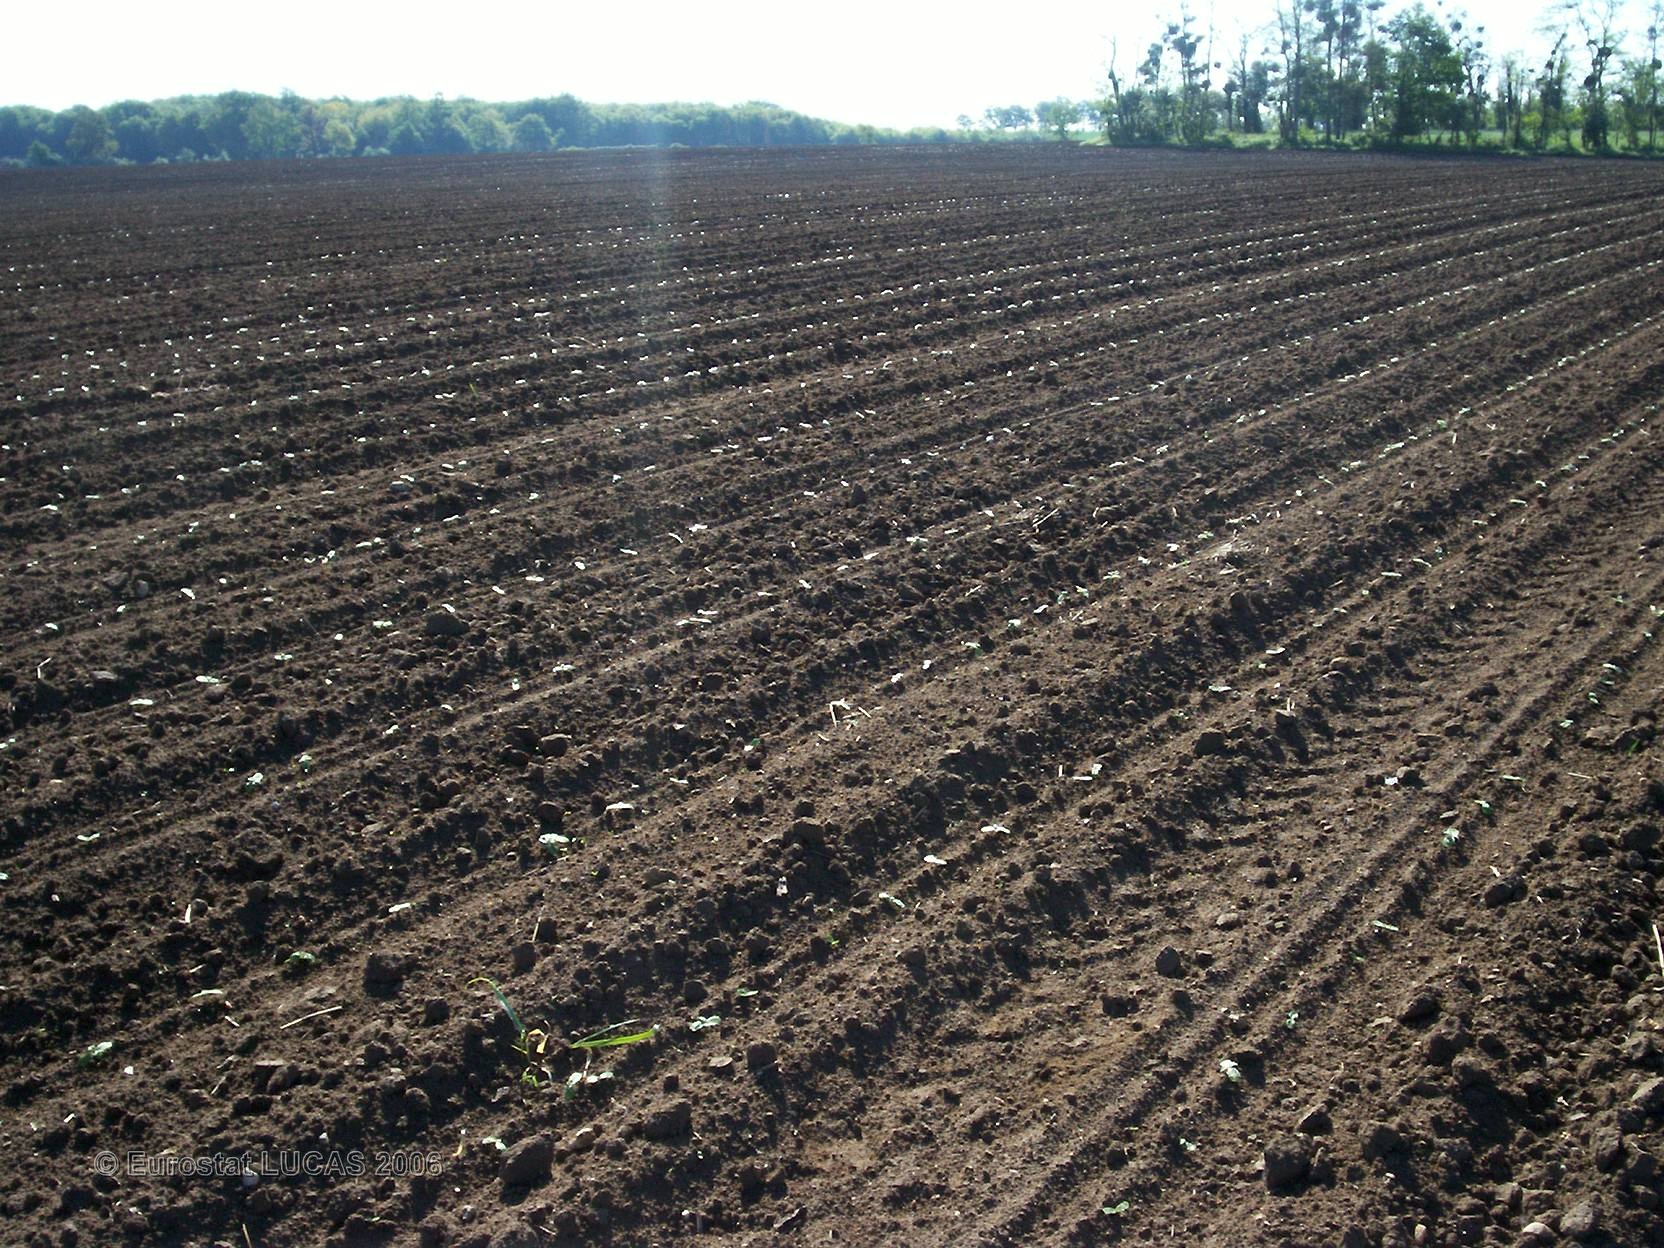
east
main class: Cropland
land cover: Sunflower
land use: Agriculture (excluding fallow land and kitchen gardens)
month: May
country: FR
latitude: 46.2672
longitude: 0.4465
